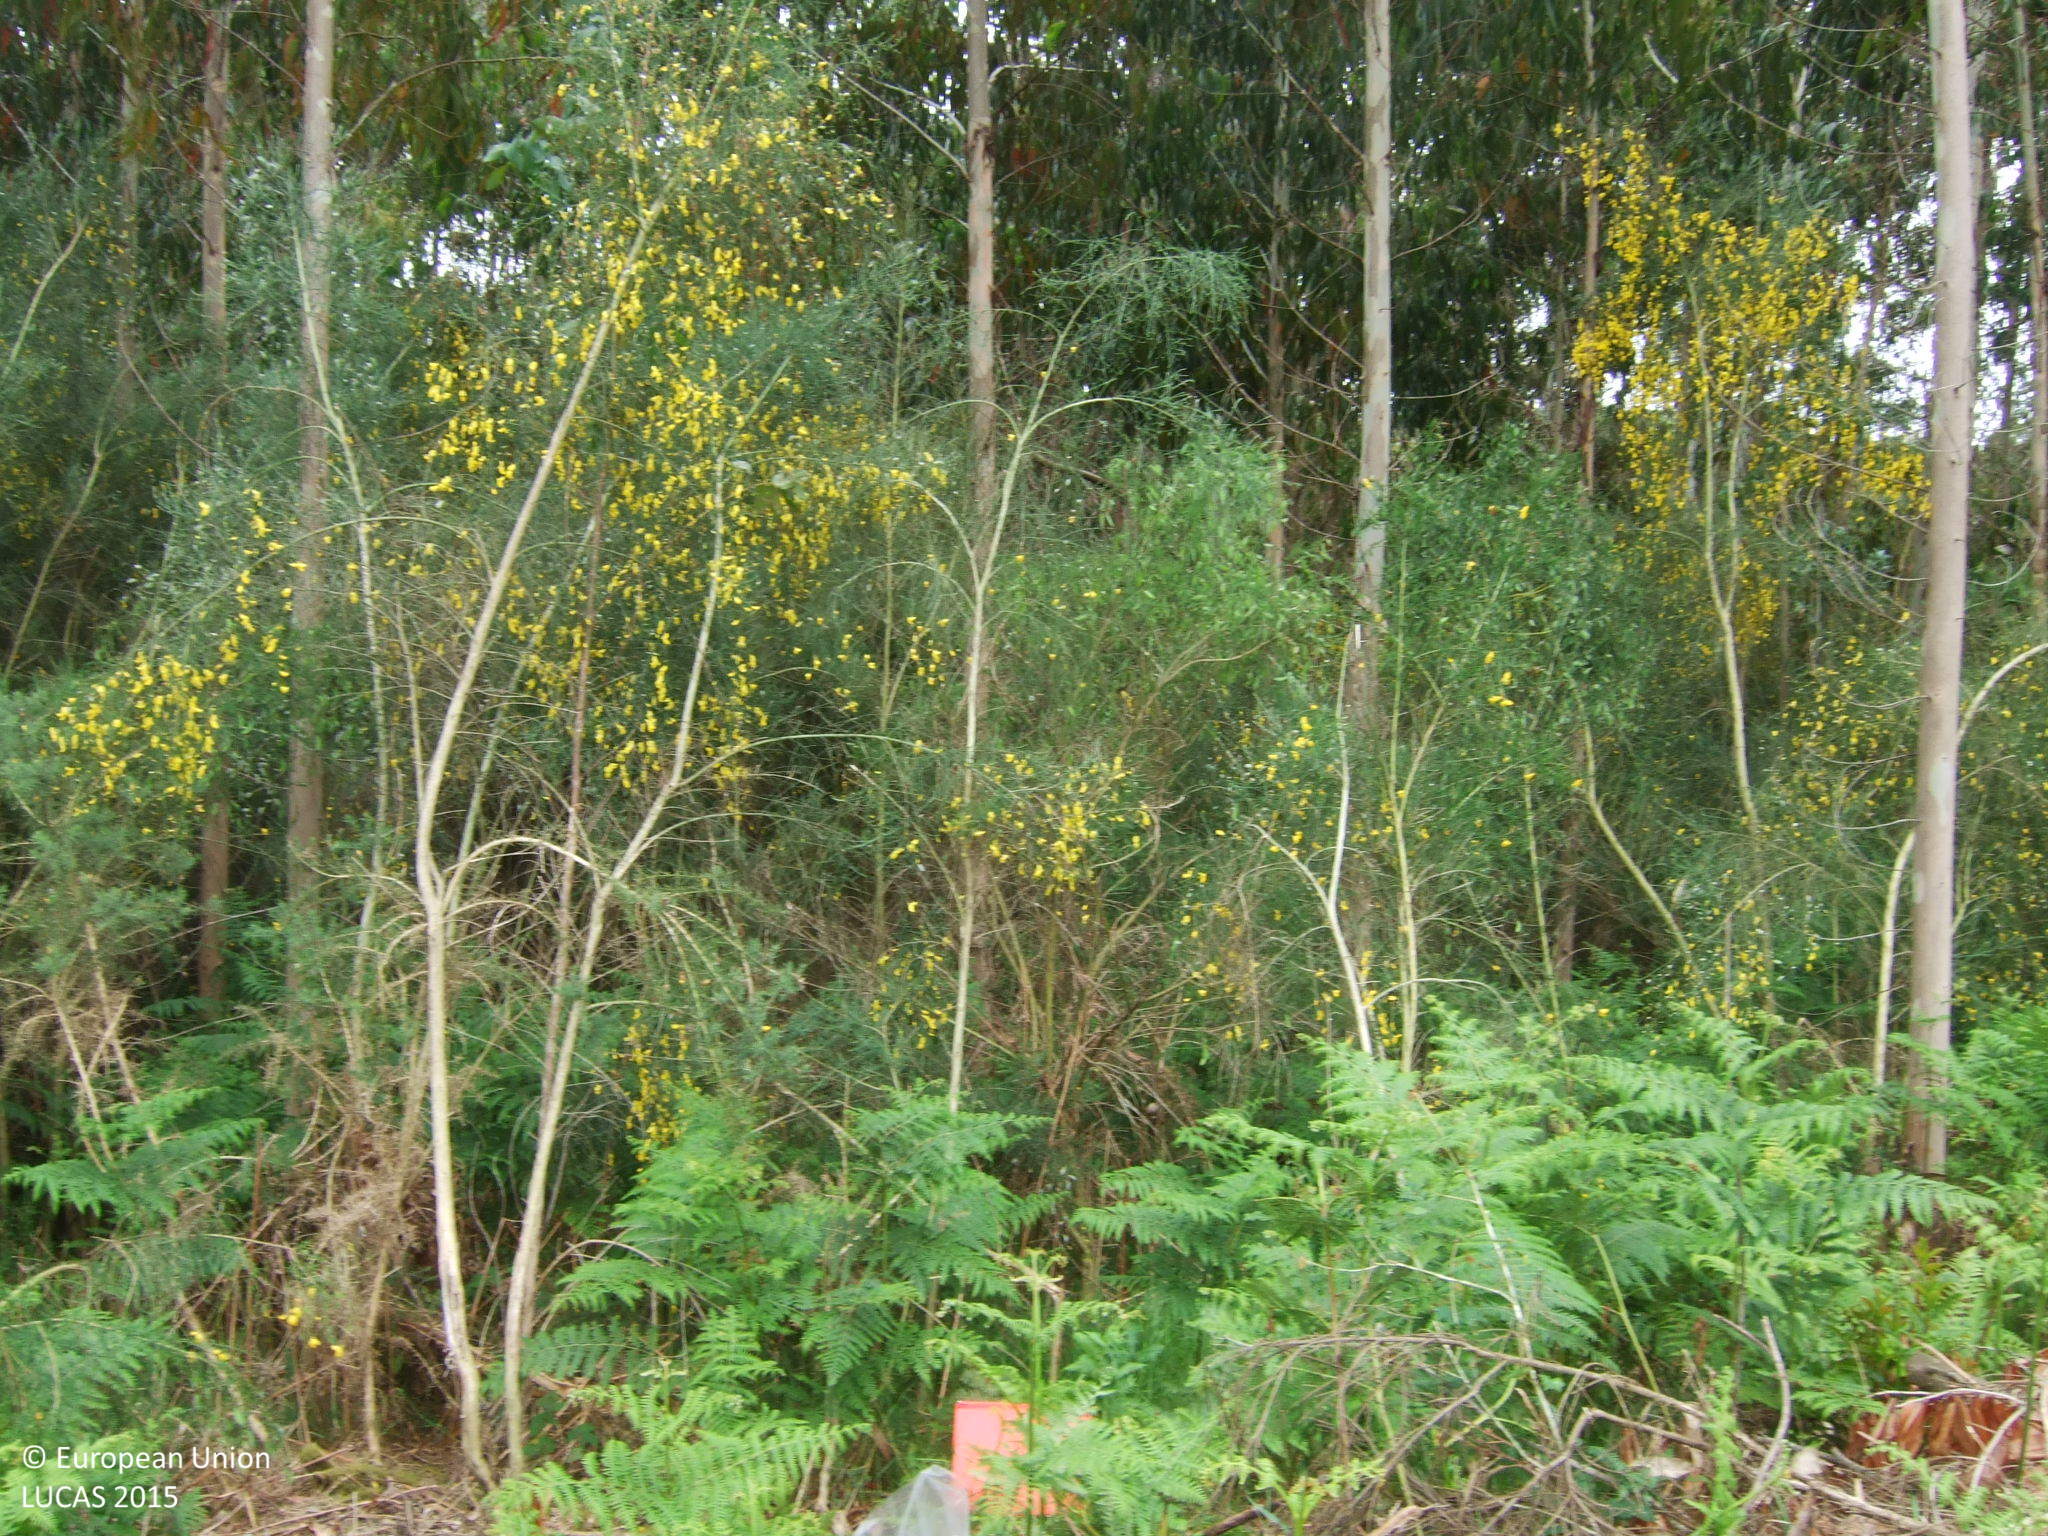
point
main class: Woodland
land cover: Broadleaved woodland
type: exotic forest
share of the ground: 25 - 50 %
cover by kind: shrubs 60 %, broadleaved forest trees 40 %
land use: Forestry
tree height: > 5 m
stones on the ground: < 10 %
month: June
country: ES
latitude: 43.5775
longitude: -7.7610
